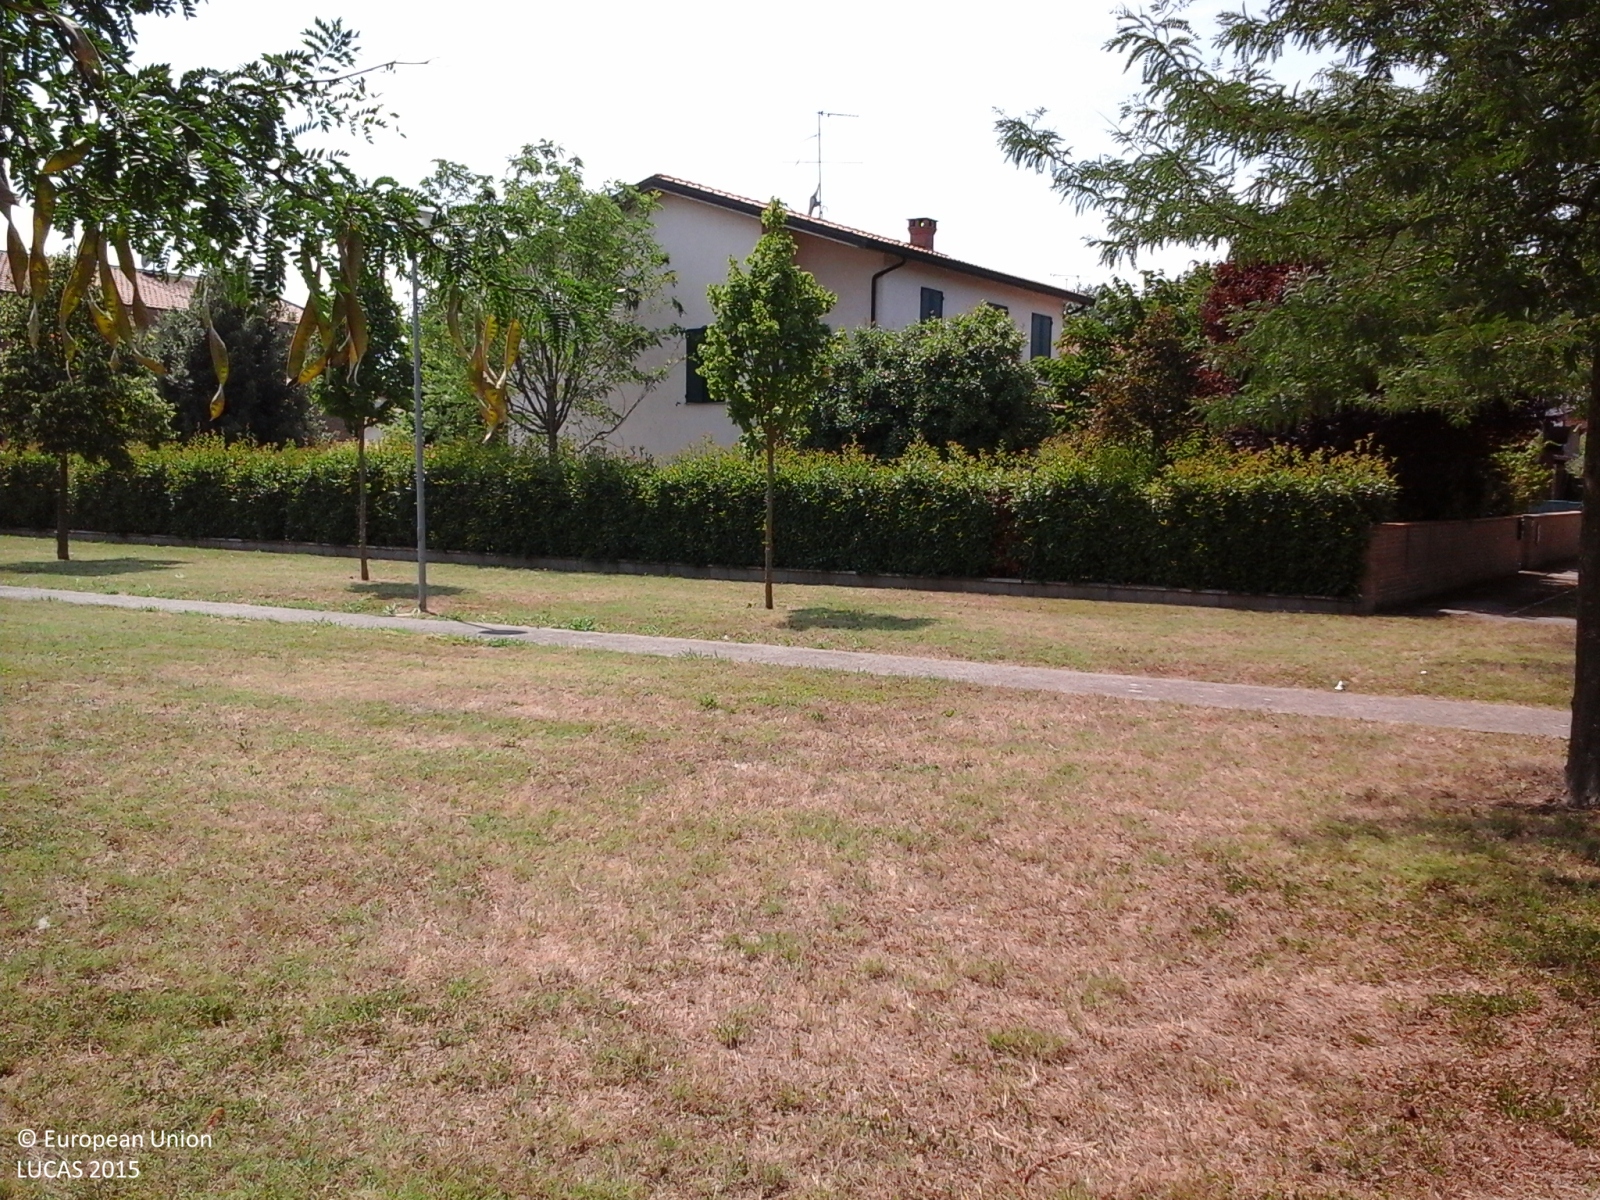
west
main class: Grassland
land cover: Grassland with sparse tree/shrub cover
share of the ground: > 75 %
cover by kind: herbaceous plants 95 %, broadleaved forest trees 5 %
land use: Residential
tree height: > 5 m
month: July
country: IT
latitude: 44.6621
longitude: 11.6488
